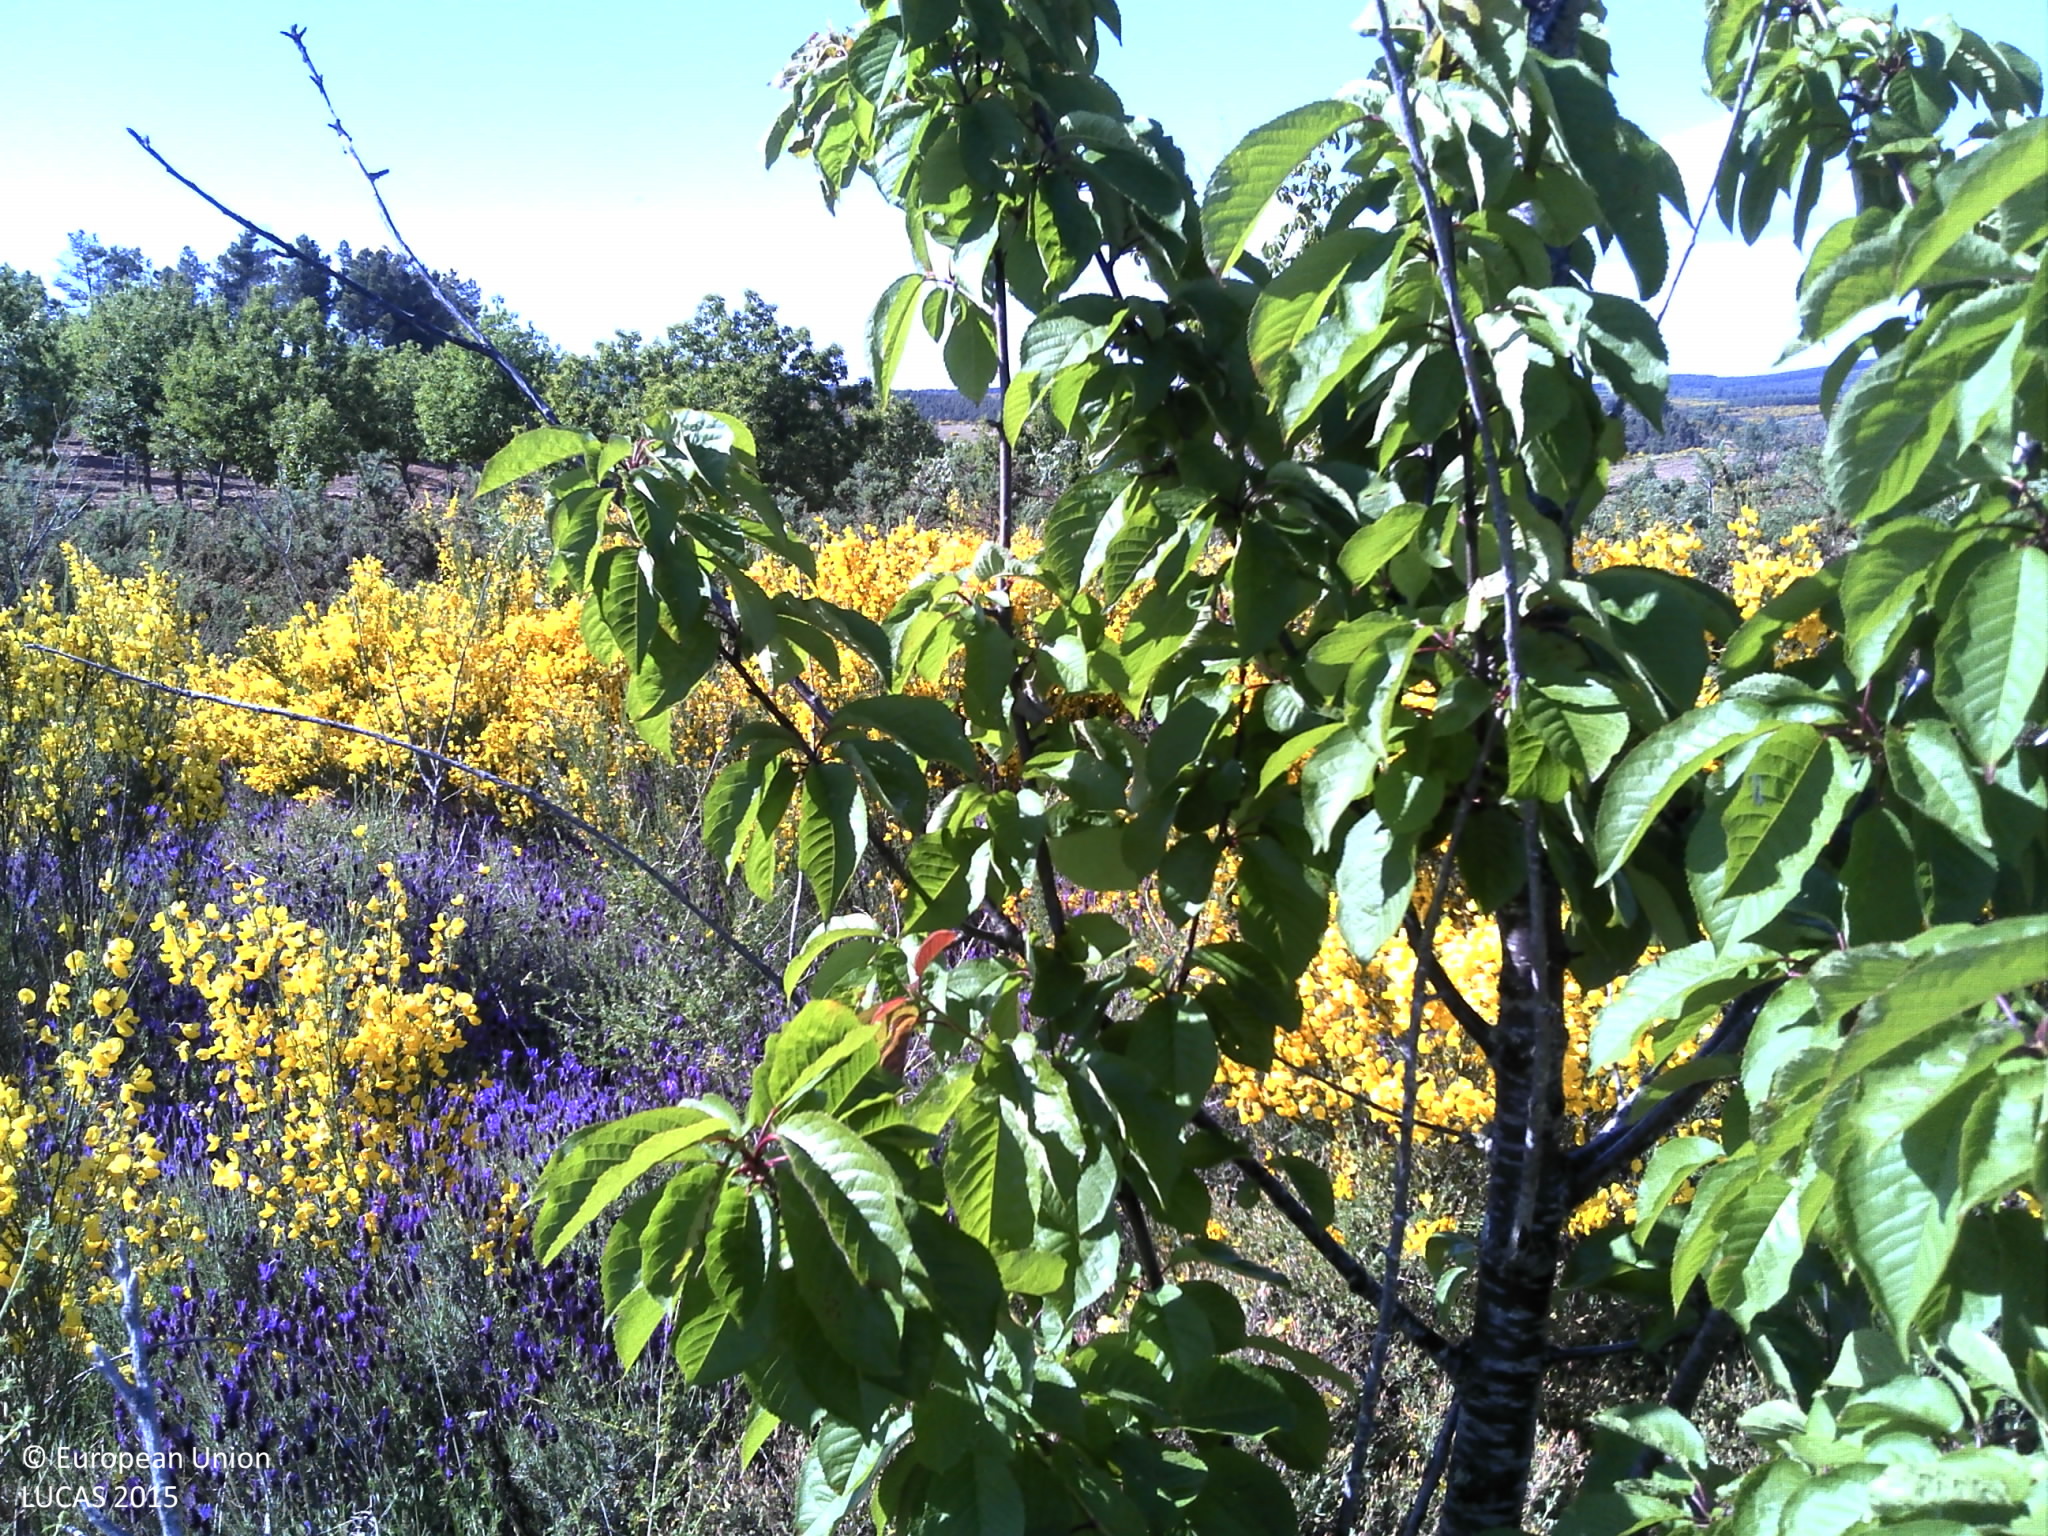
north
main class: Shrubland
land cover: Shrubland with sparse tree cover
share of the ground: > 75 %
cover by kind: shrubs 90 %, broadleaved forest trees 5 %, herbaceous plants 5 %
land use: Abandoned areas
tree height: < 5 m
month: May
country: PT
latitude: 41.6427
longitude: -6.3698
